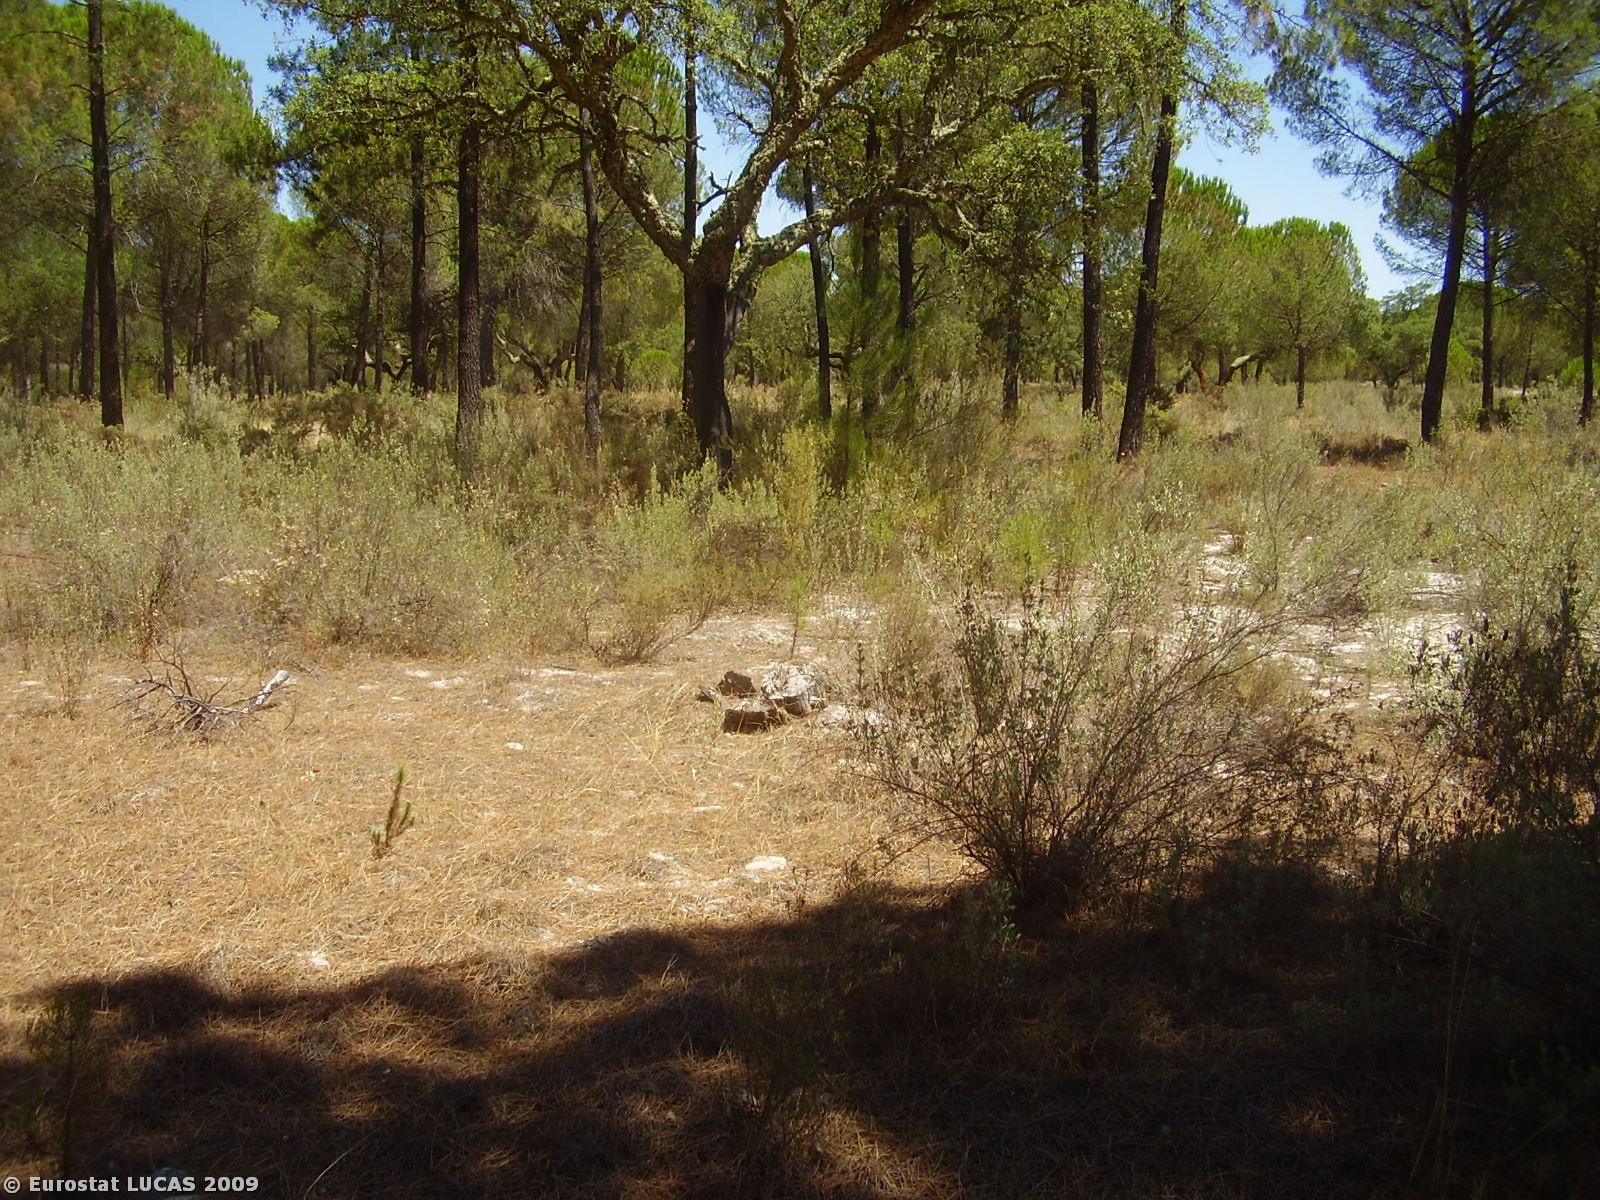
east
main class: Woodland
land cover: Coniferous woodland
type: coniferous forest of the mediterranean region
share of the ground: 10 - 25 %
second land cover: Spontaneously vegetated surfaces
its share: 25 - 50 %
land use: Forestry
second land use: Fallow land
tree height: > 5 m
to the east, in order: Coniferous woodland; Spontaneously vegetated surfaces; Coniferous woodland
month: July
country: PT
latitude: 38.1571
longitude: -8.4063
